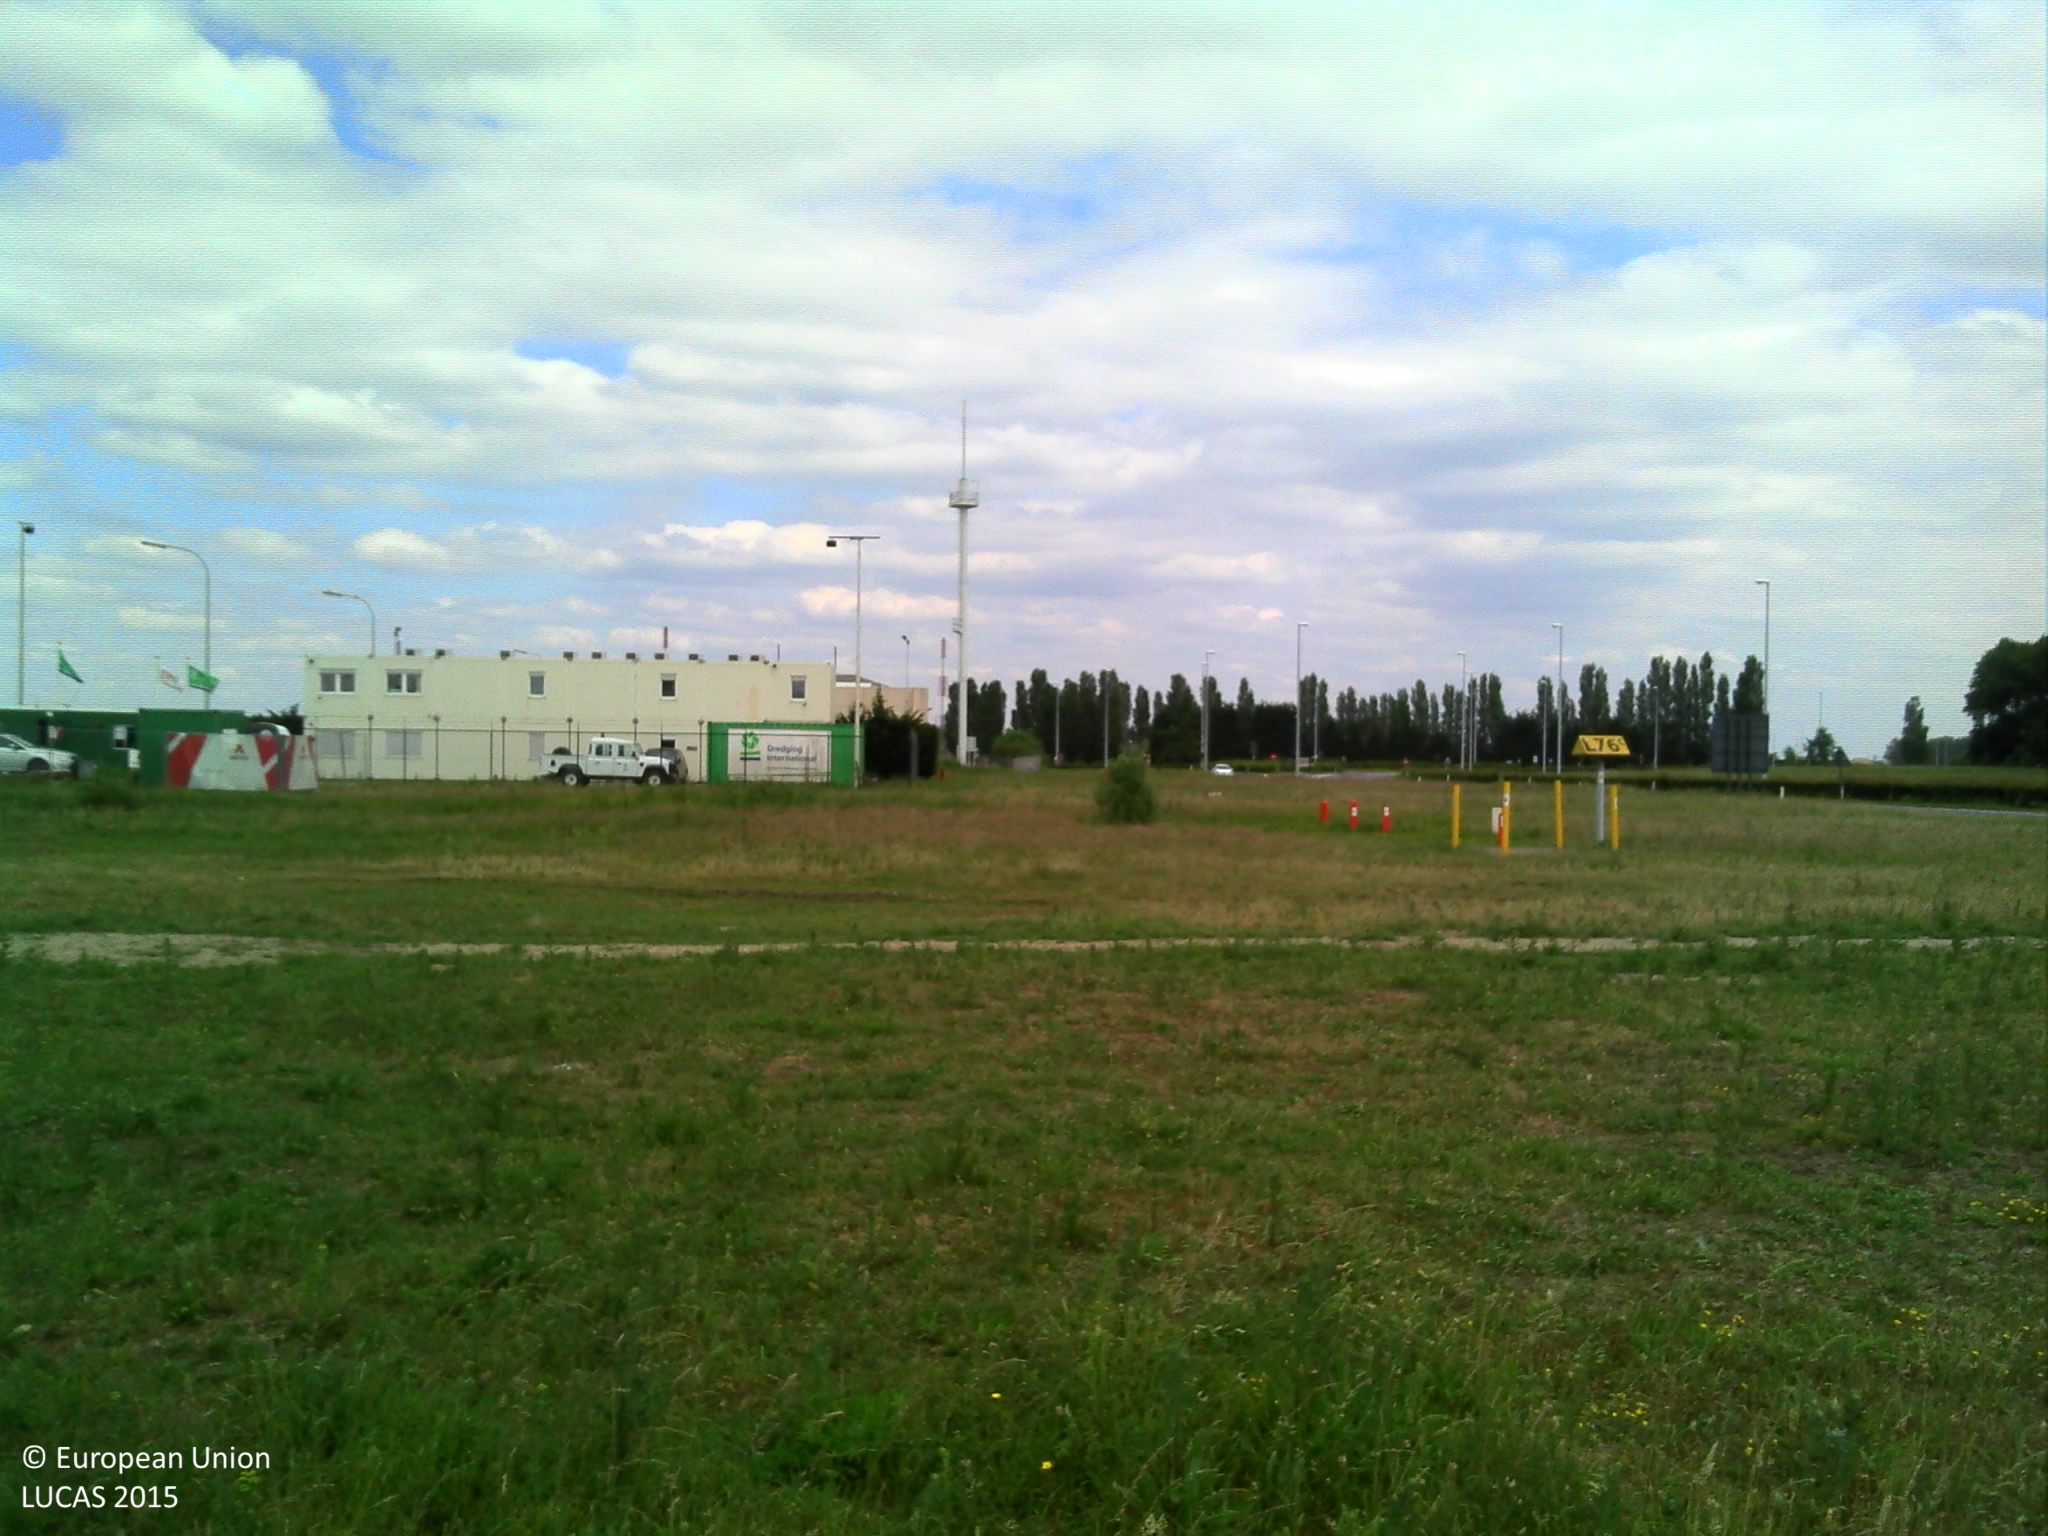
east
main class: Grassland
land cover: Spontaneously vegetated surfaces
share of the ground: > 75 %
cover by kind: herbaceous plants 100 %
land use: Semi-natural and natural areas not in use
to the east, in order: Spontaneously vegetated surfaces; Ditches and canals; Spontaneously vegetated surfaces; Artificial constructions in urban areas; Grassland without tree/shrub cover
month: June
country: BE
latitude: 51.2662
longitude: 4.2766
